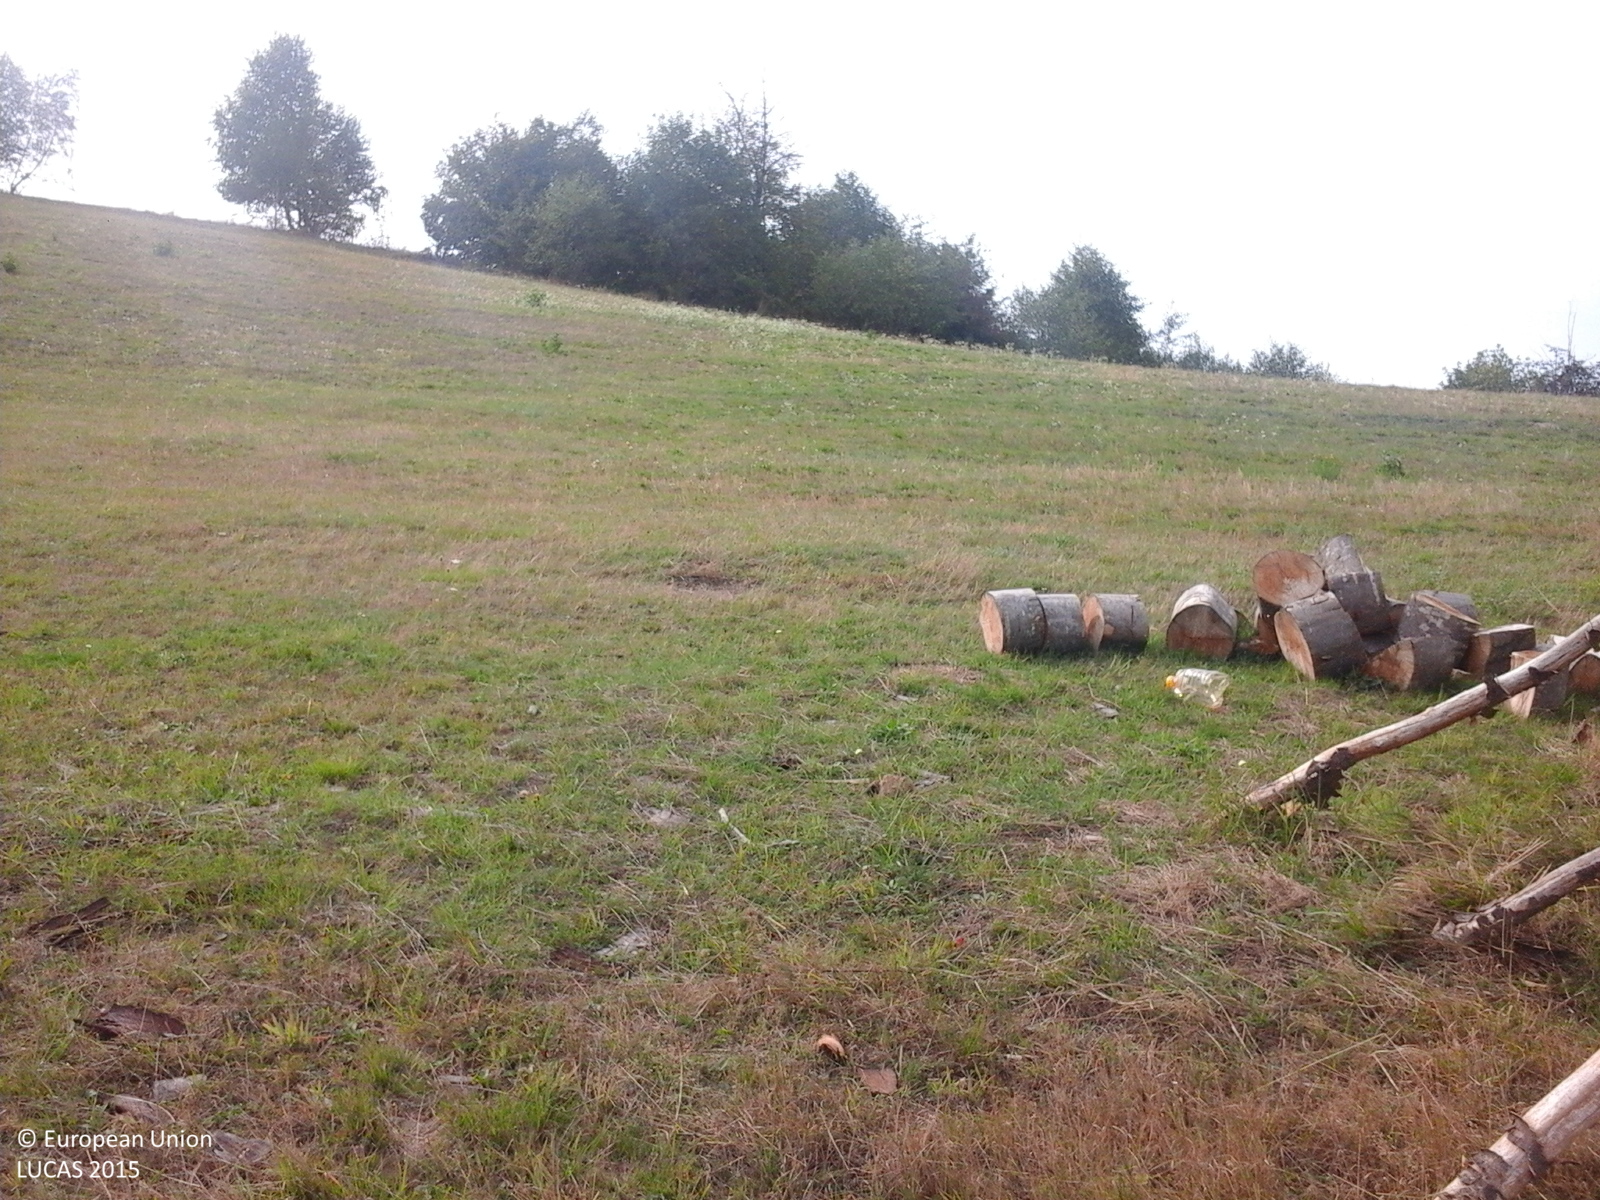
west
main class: Grassland
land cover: Grassland without tree/shrub cover
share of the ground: > 75 %
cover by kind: herbaceous plants 100 %
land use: Agriculture (excluding fallow land and kitchen gardens)
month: September
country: RO
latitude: 47.4143
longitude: 24.0126
